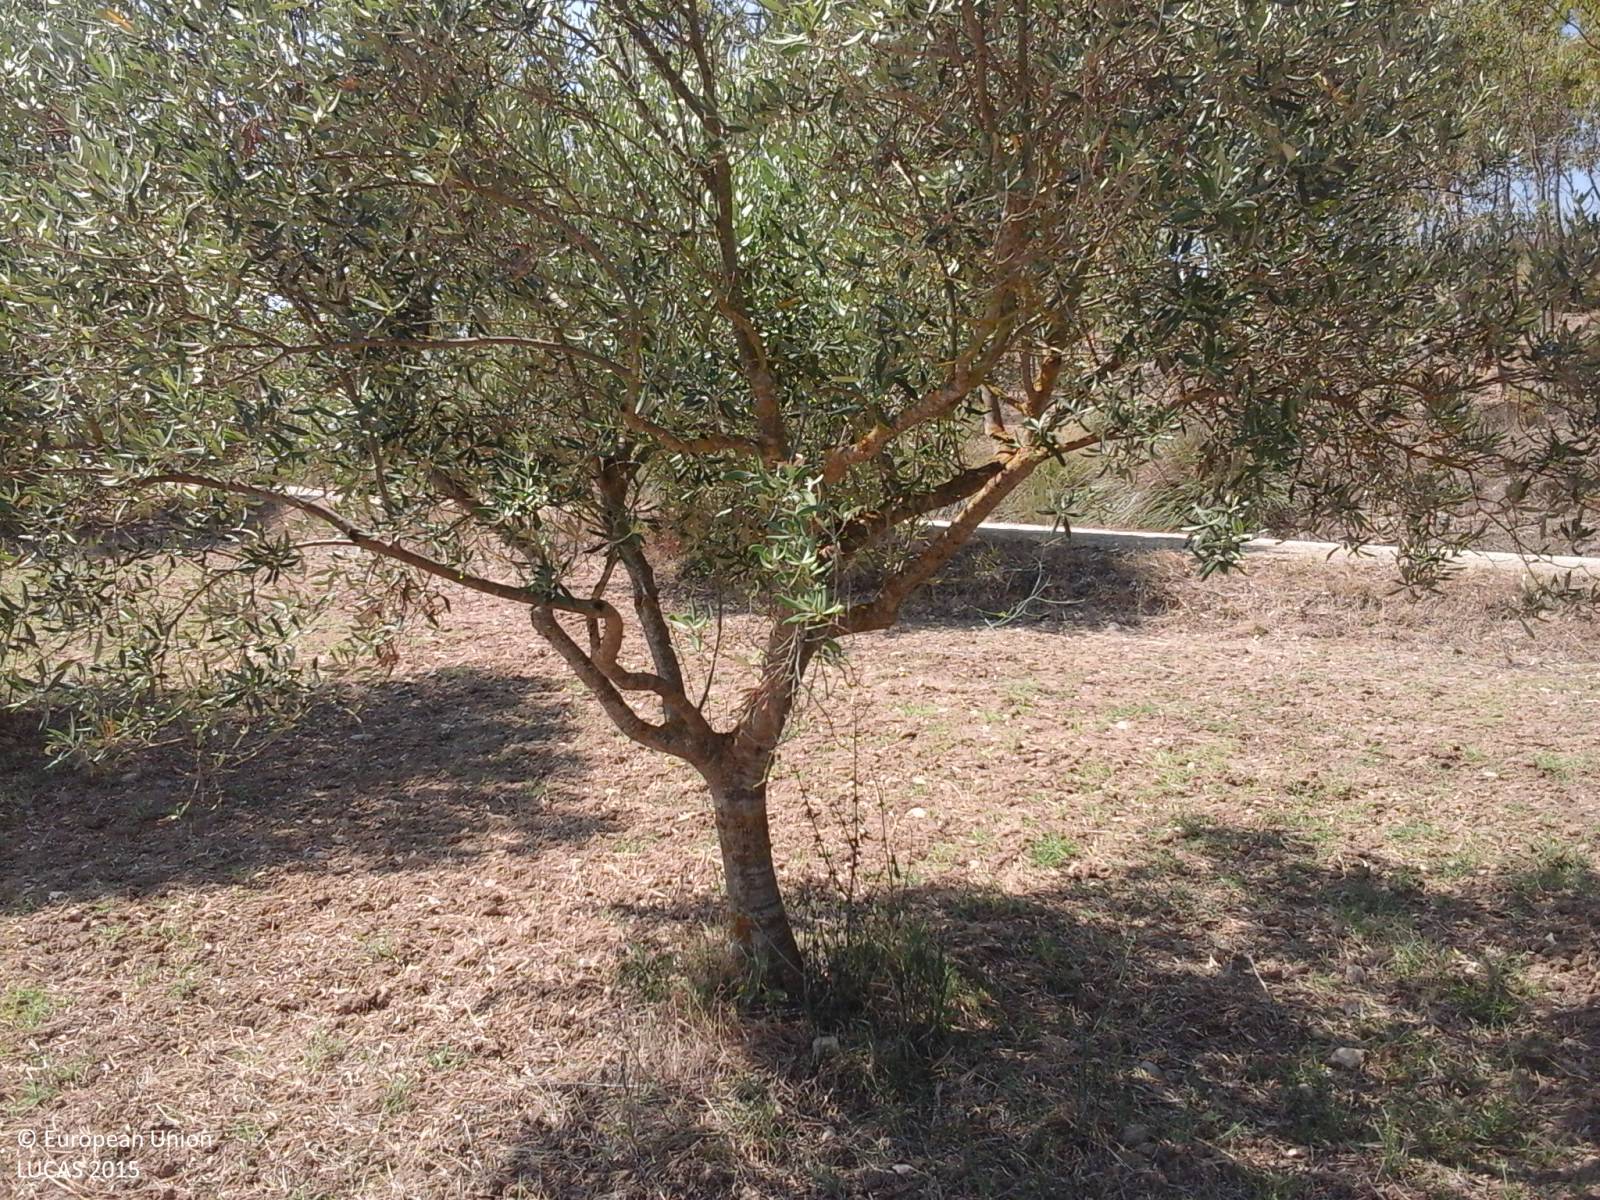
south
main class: Cropland
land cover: Olive groves
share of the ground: > 75 %
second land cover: Other bare soil
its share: > 75 %
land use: Agriculture (excluding fallow land and kitchen gardens)
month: July
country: IT
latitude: 39.6273
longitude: 8.8996
